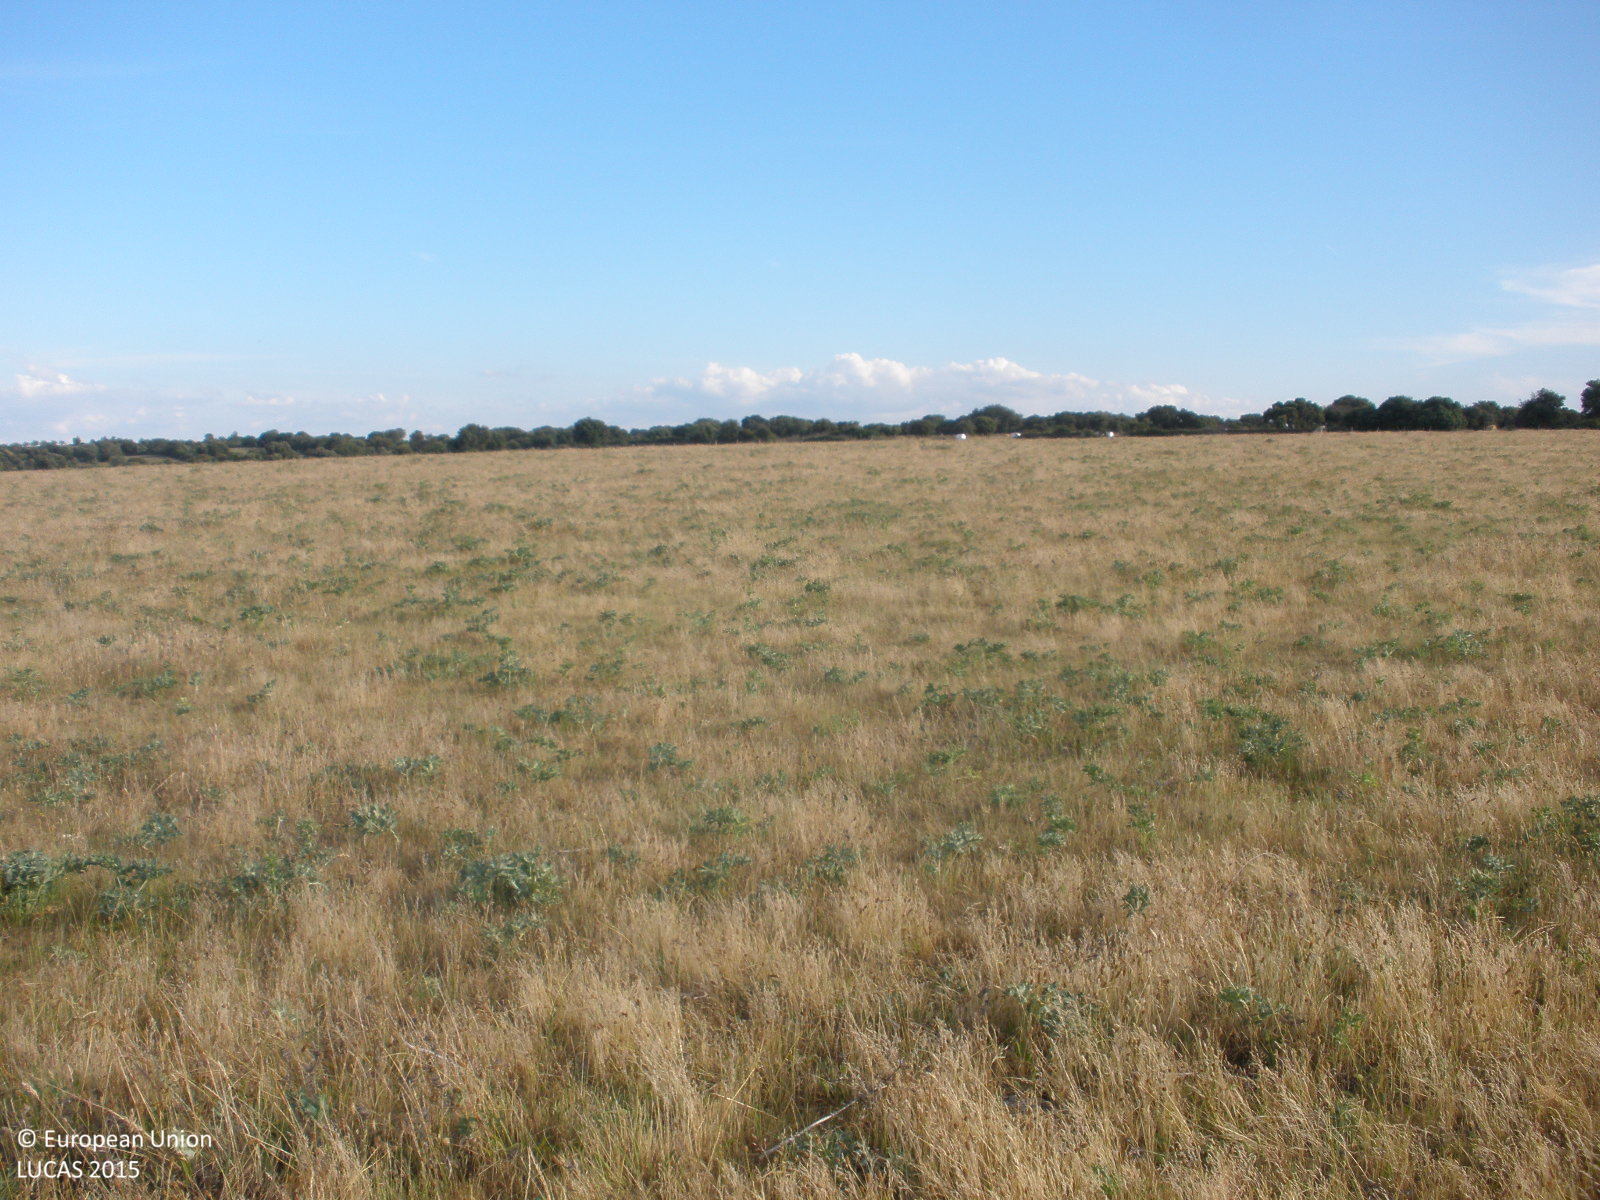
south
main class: Grassland
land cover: Grassland without tree/shrub cover
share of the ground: > 75 %
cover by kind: herbaceous plants 100 %
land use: Agriculture (excluding fallow land and kitchen gardens)
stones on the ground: 10 - 25 %
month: June
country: ES
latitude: 40.6957
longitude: -6.7469
